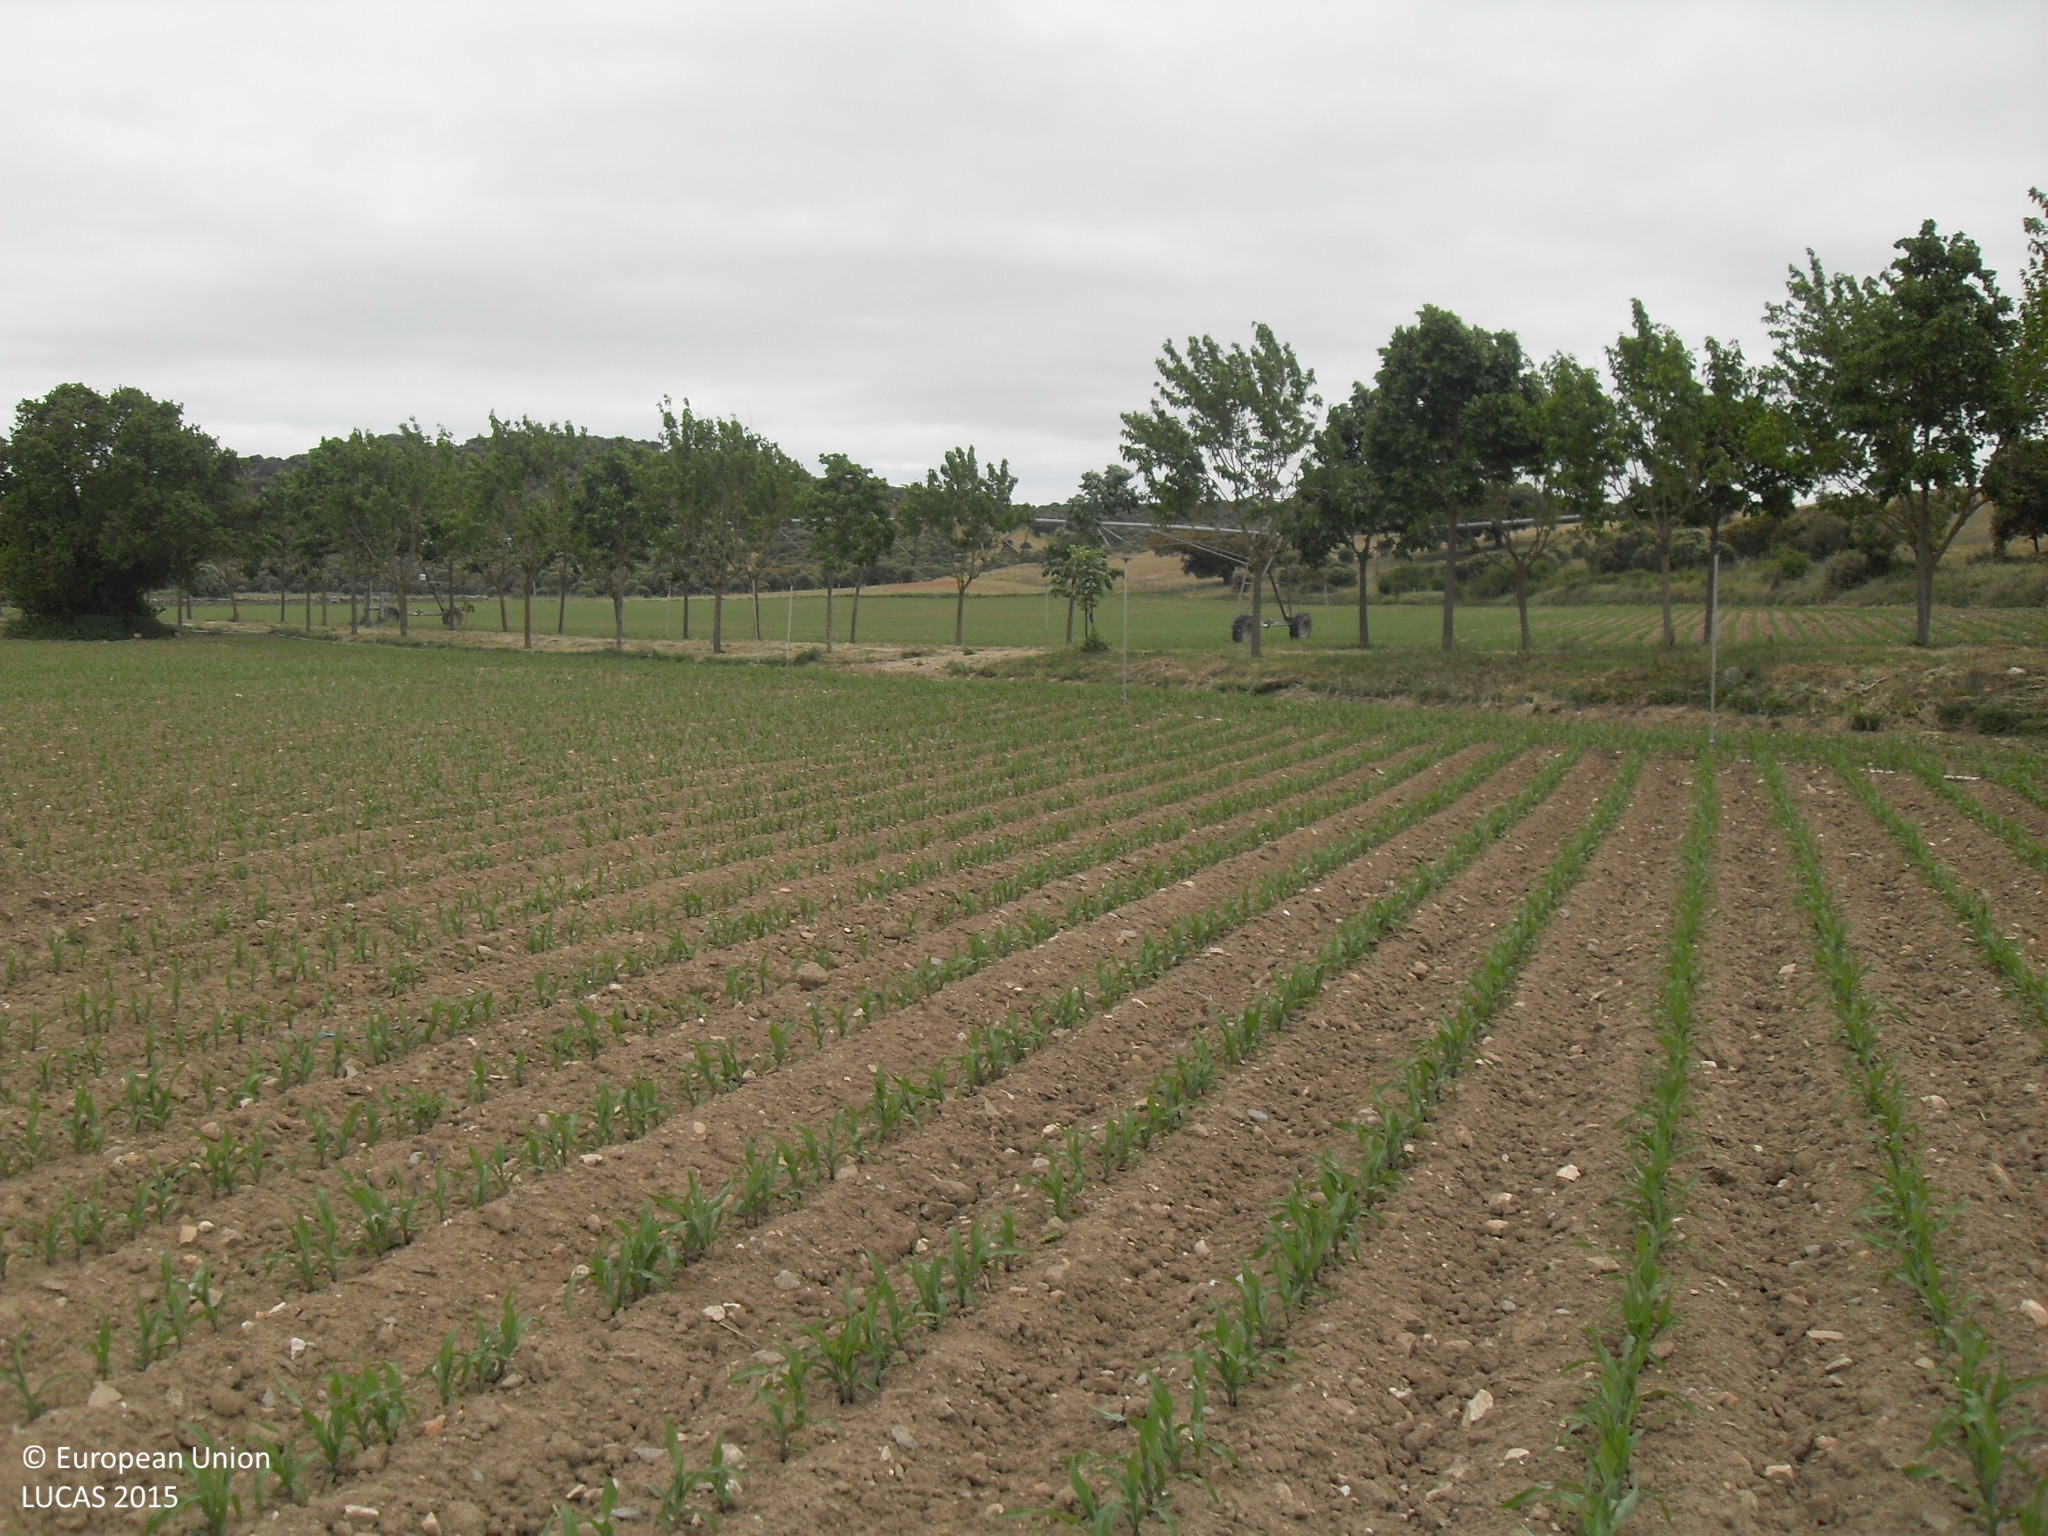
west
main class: Cropland
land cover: Maize
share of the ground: > 75 %
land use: Agriculture (excluding fallow land and kitchen gardens)
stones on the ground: < 10 %
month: May
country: ES
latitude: 40.6889
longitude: -5.6813
